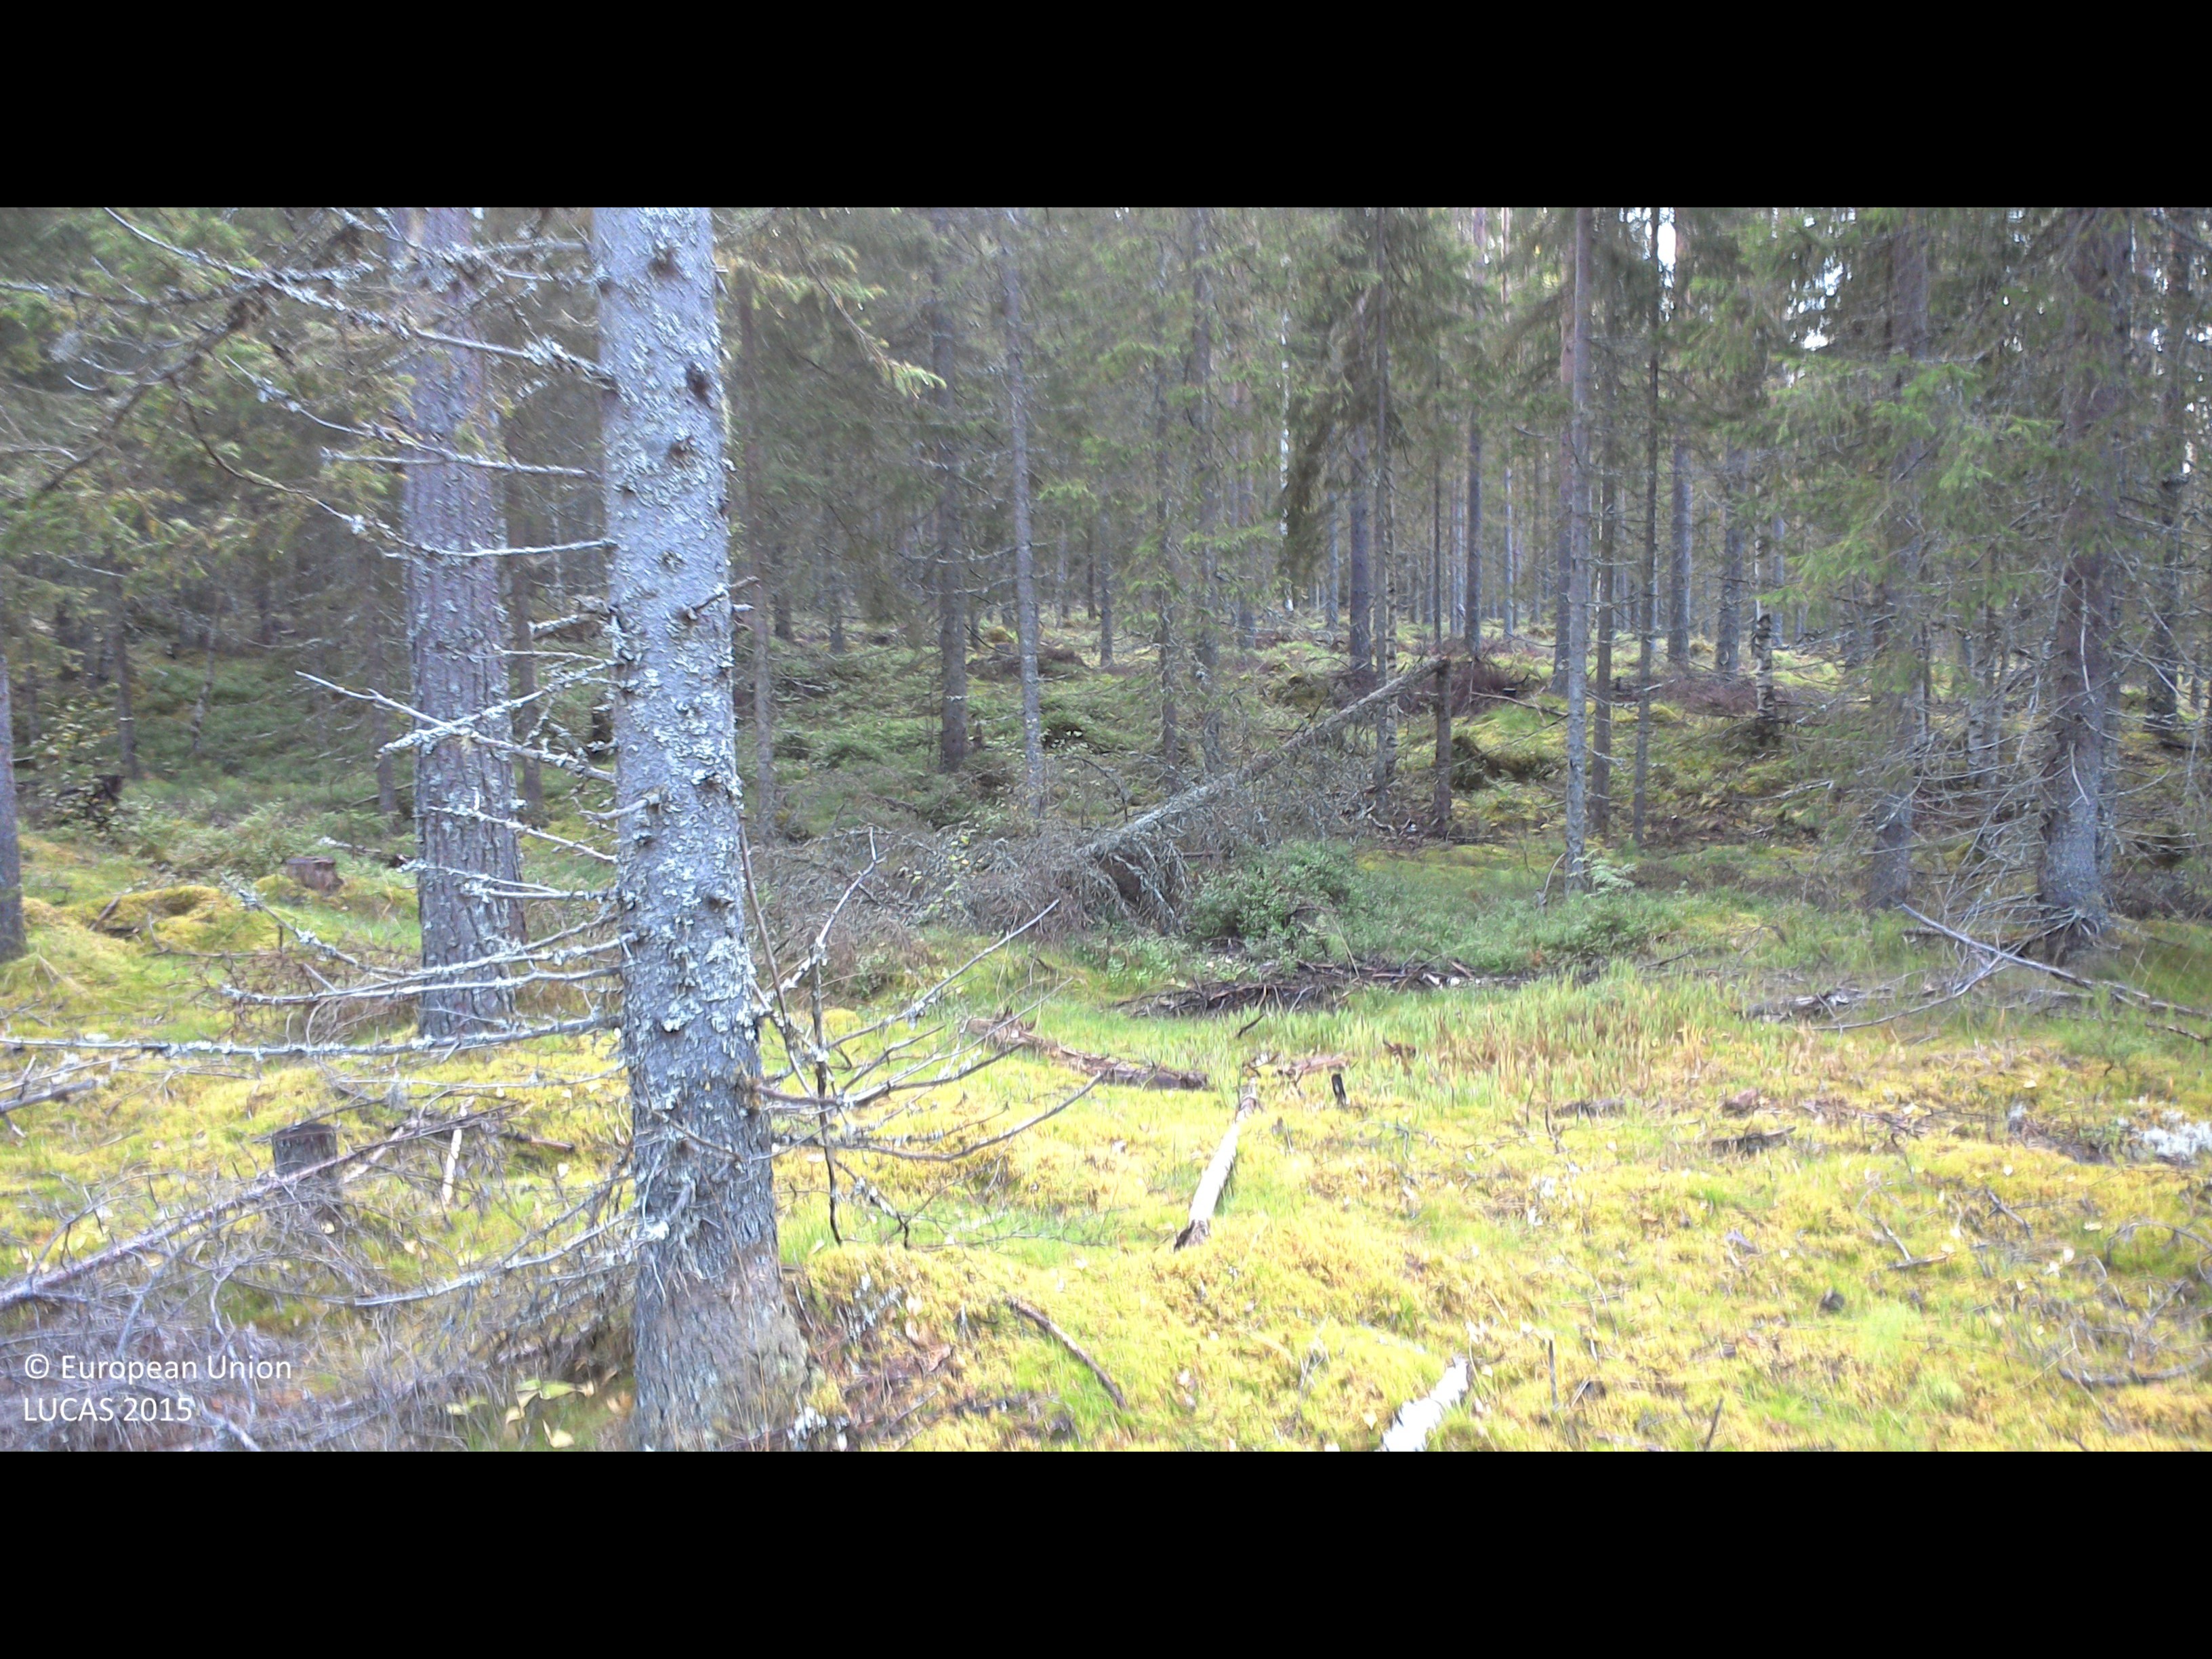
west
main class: Woodland
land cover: Pine dominated coniferous woodland
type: boreal forest
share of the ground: 50 - 75 %
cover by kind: coniferous forest trees 50 %, shrubs 50 %
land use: Forestry
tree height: > 5 m
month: September
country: SE
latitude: 63.7450
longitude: 19.5620
